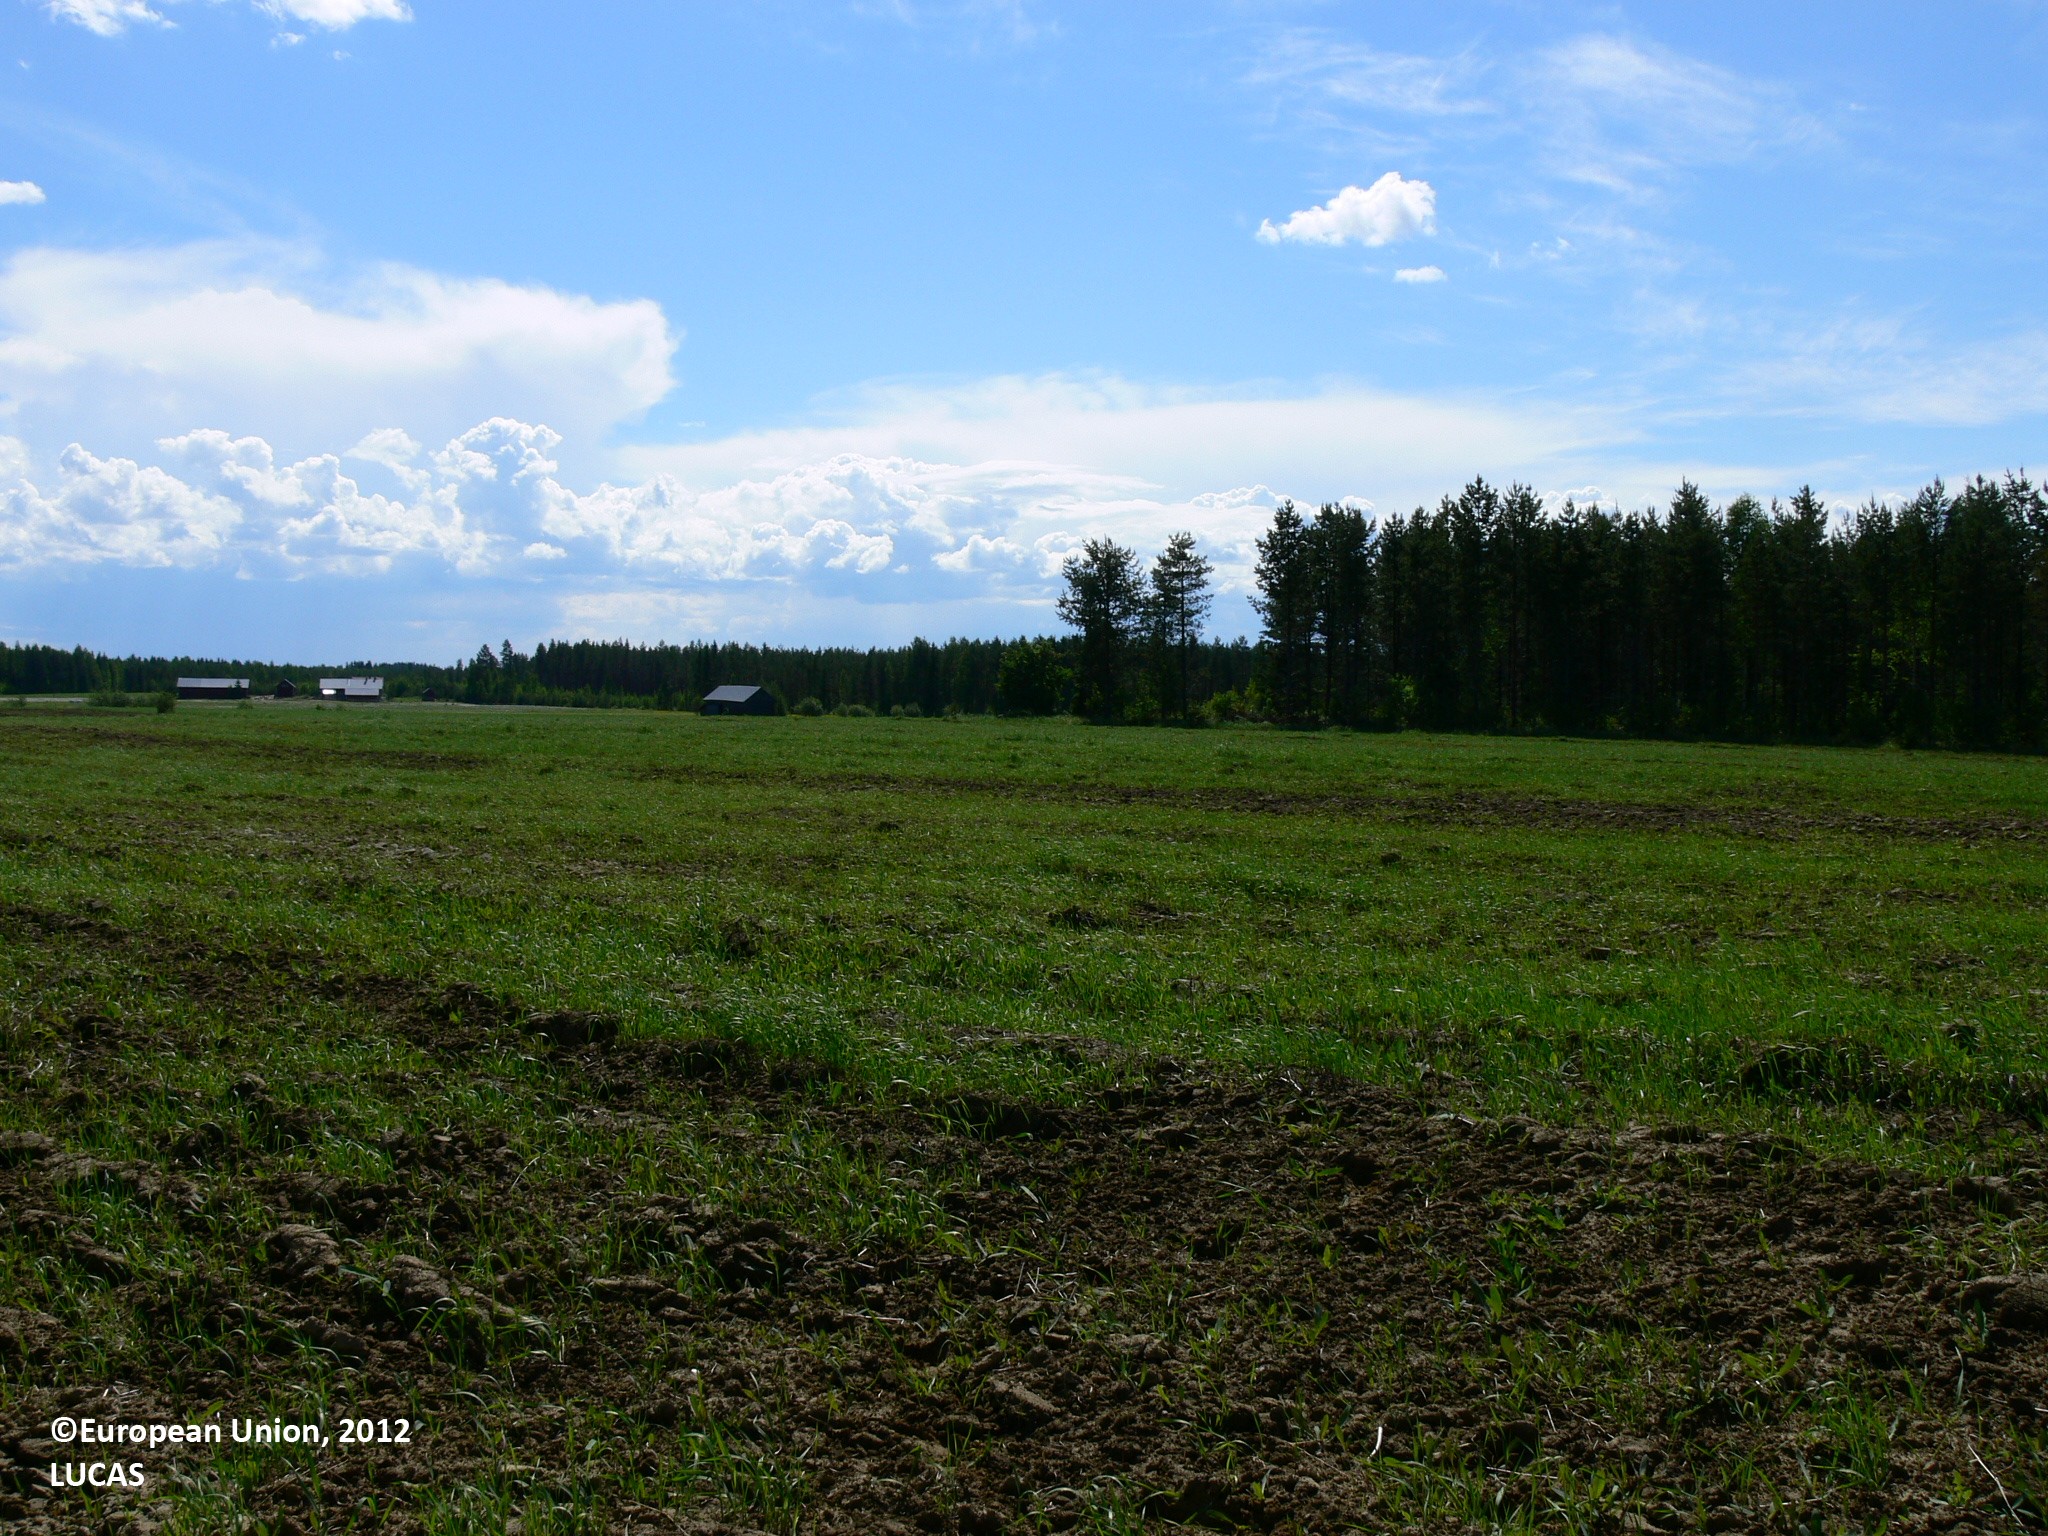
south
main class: Grassland
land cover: Spontaneously vegetated surfaces
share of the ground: < 10 %
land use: Fallow land
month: June
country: FI
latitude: 62.3193
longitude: 30.3657
